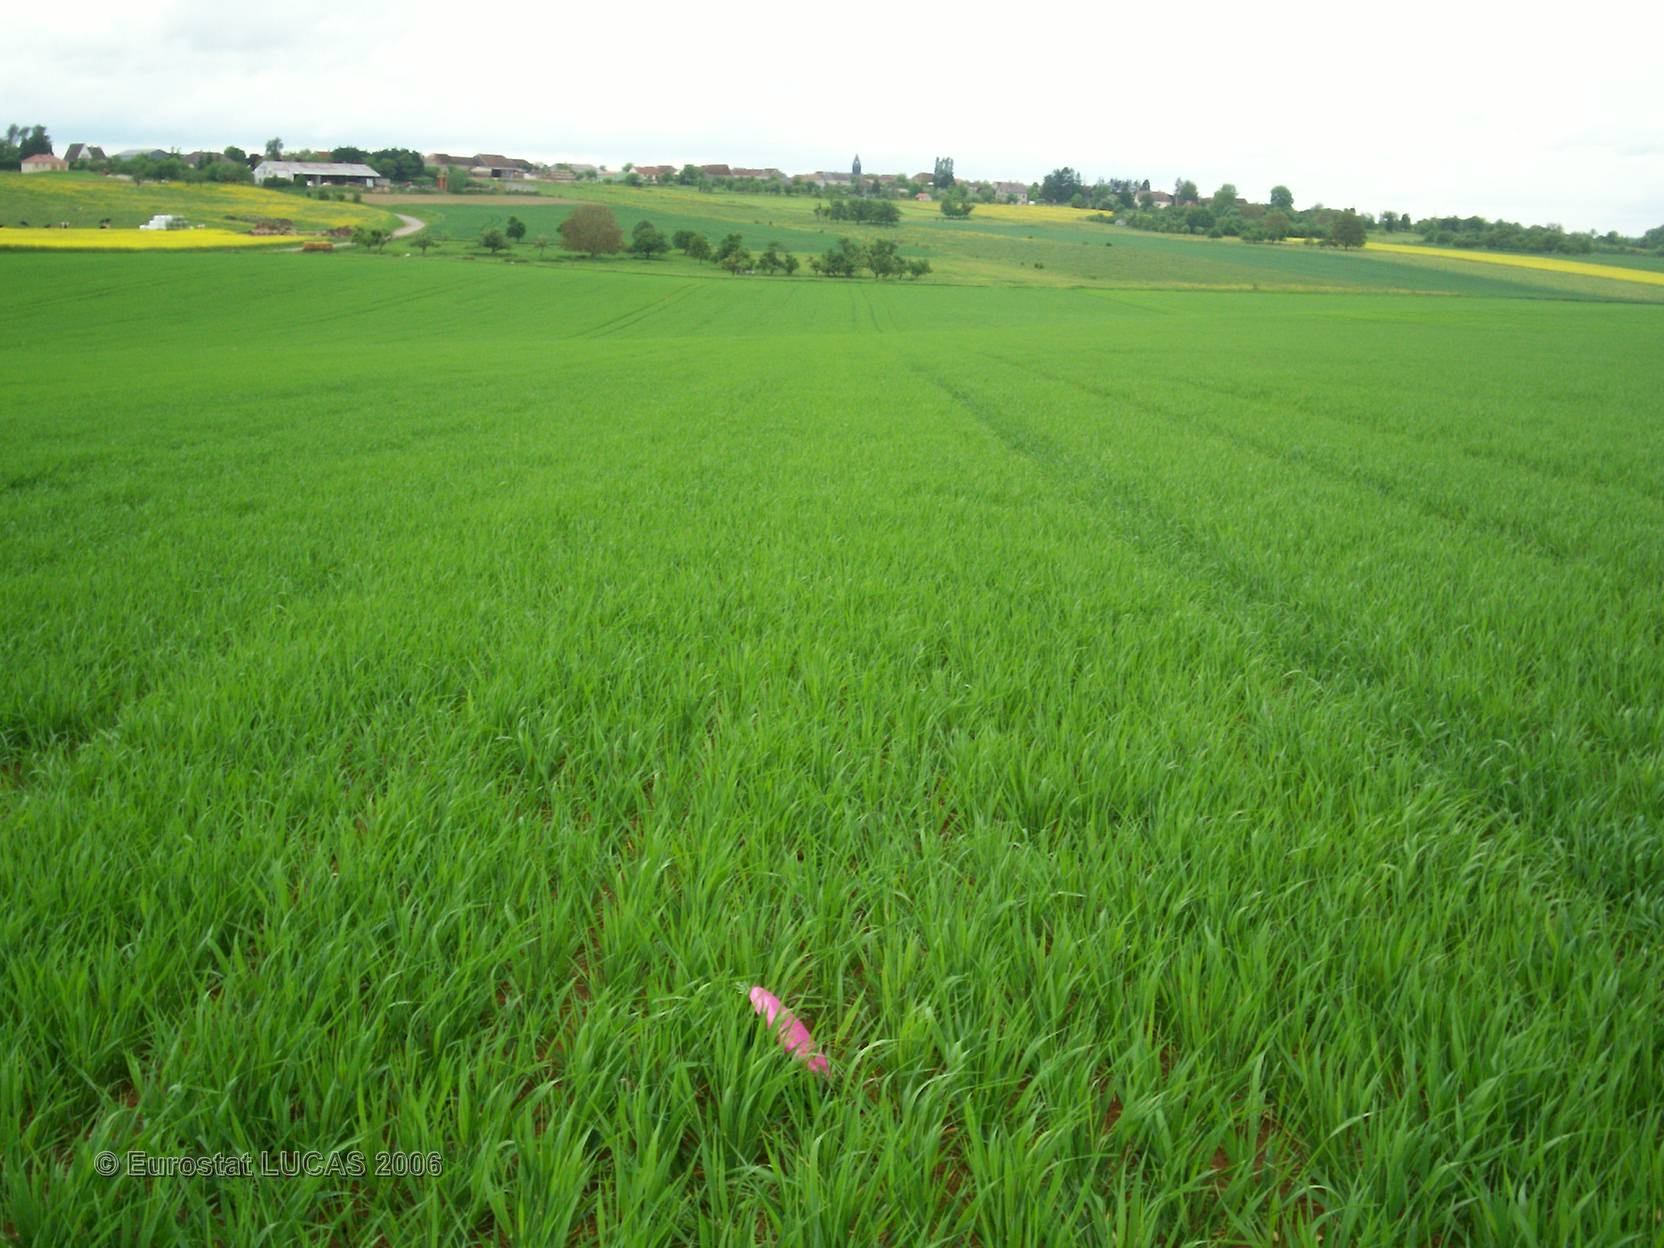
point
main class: Cropland
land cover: Barley
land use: Agriculture (excluding fallow land and kitchen gardens)
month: May
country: FR
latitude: 48.1750
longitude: 4.4705
